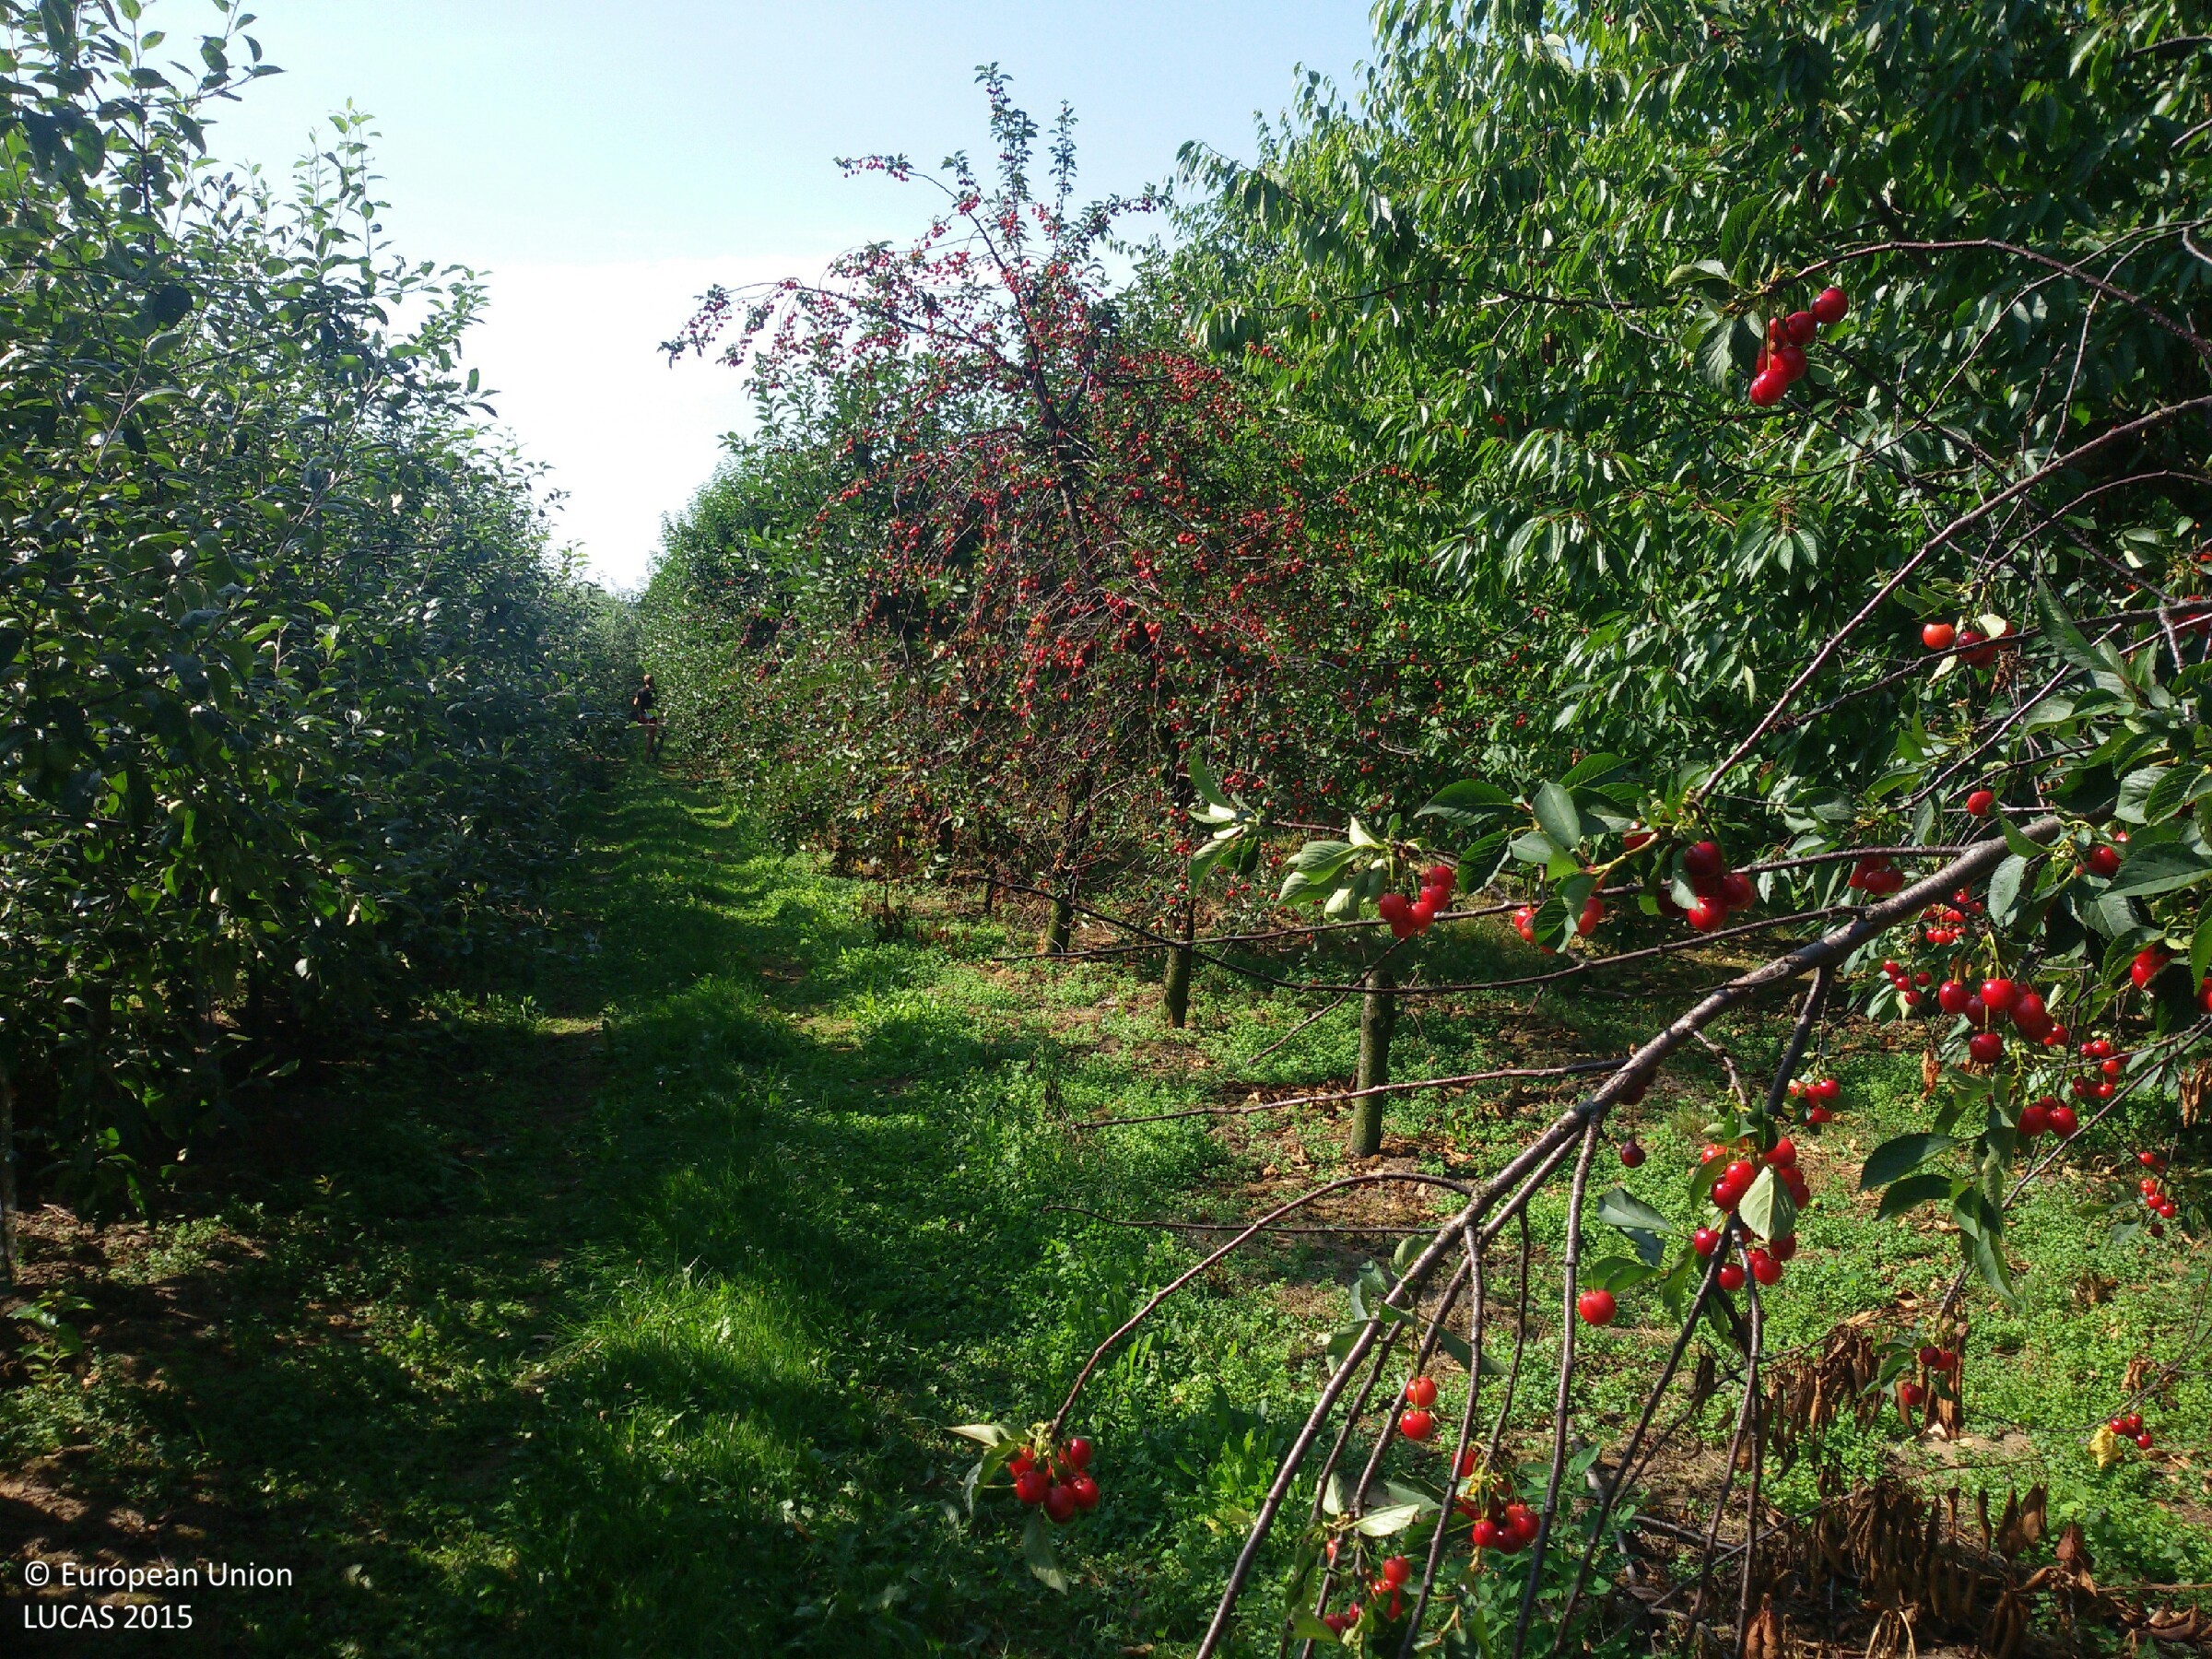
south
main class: Cropland
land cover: Apple fruit
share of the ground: 50 - 75 %
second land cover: Cherry fruit
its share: 50 - 75 %
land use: Agriculture (excluding fallow land and kitchen gardens)
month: July
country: PL
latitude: 51.7307
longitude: 20.6825
